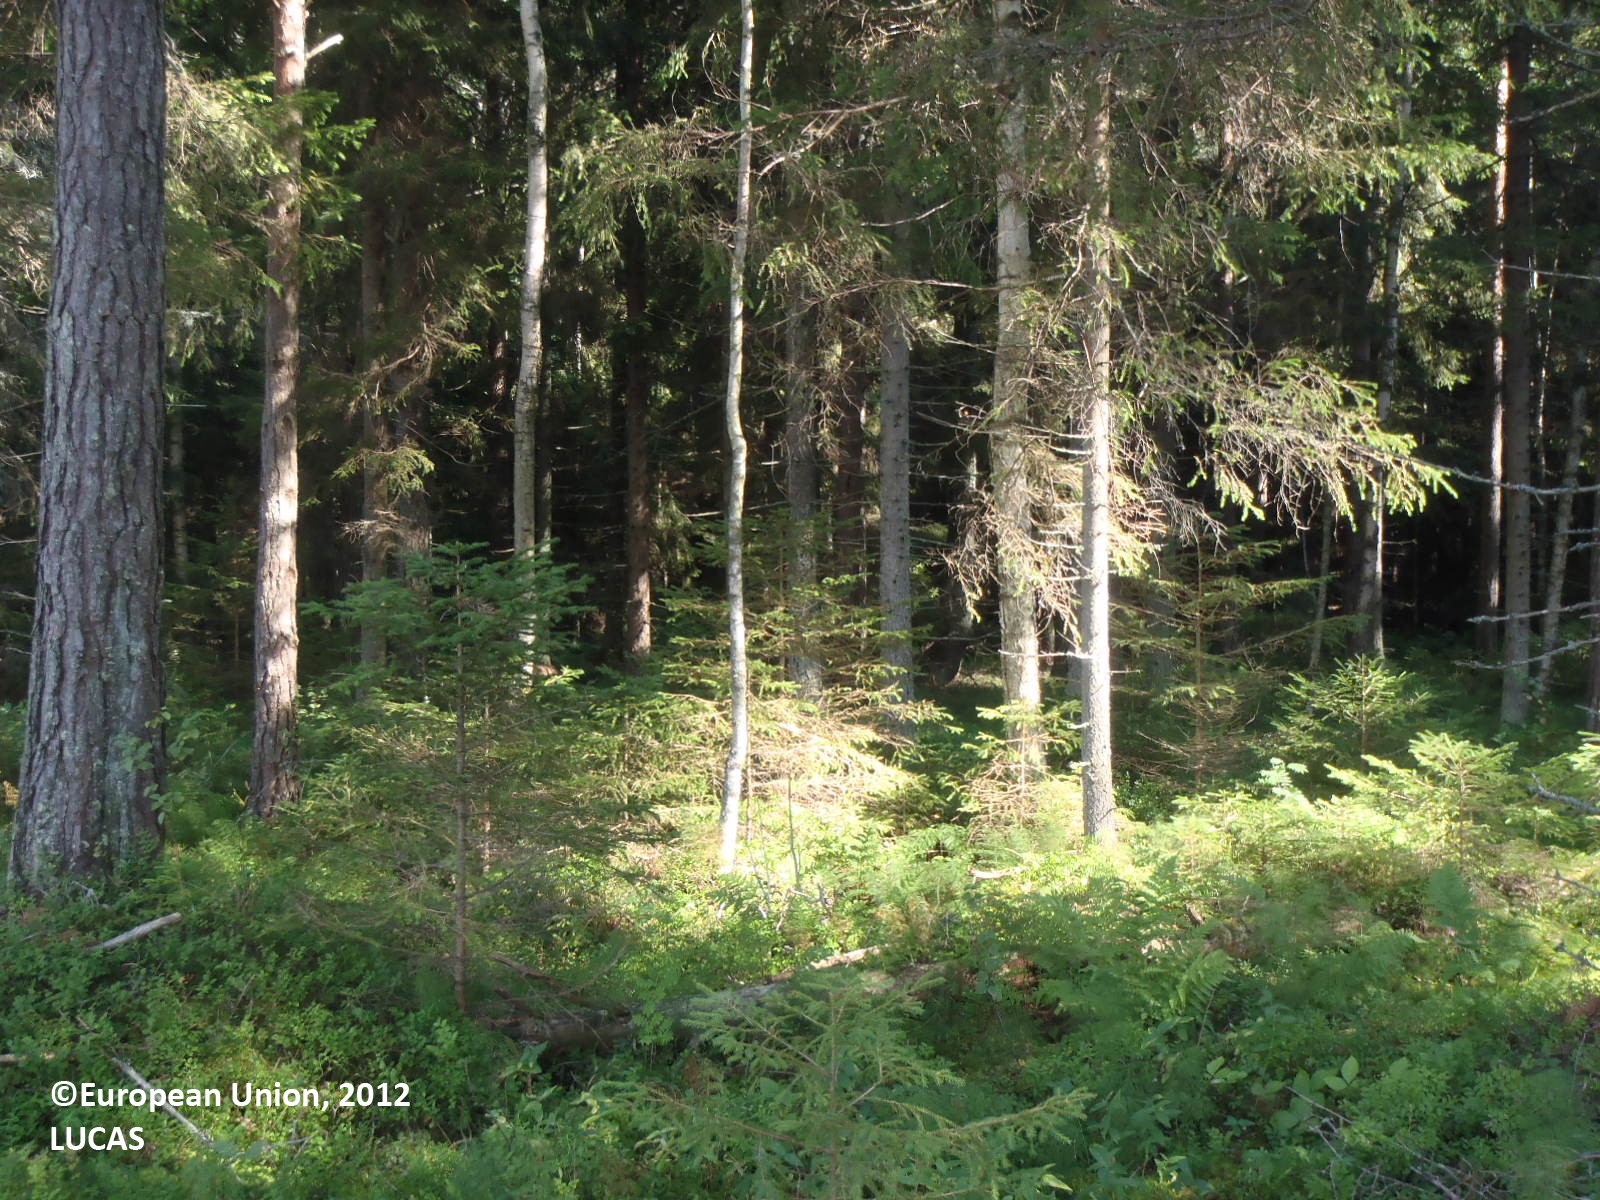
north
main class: Woodland
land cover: Spruce dominated mixed woodland
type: boreal forest
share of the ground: > 75 %
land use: Forestry
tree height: > 5 m
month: August
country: FI
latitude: 60.3292
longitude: 20.0578
